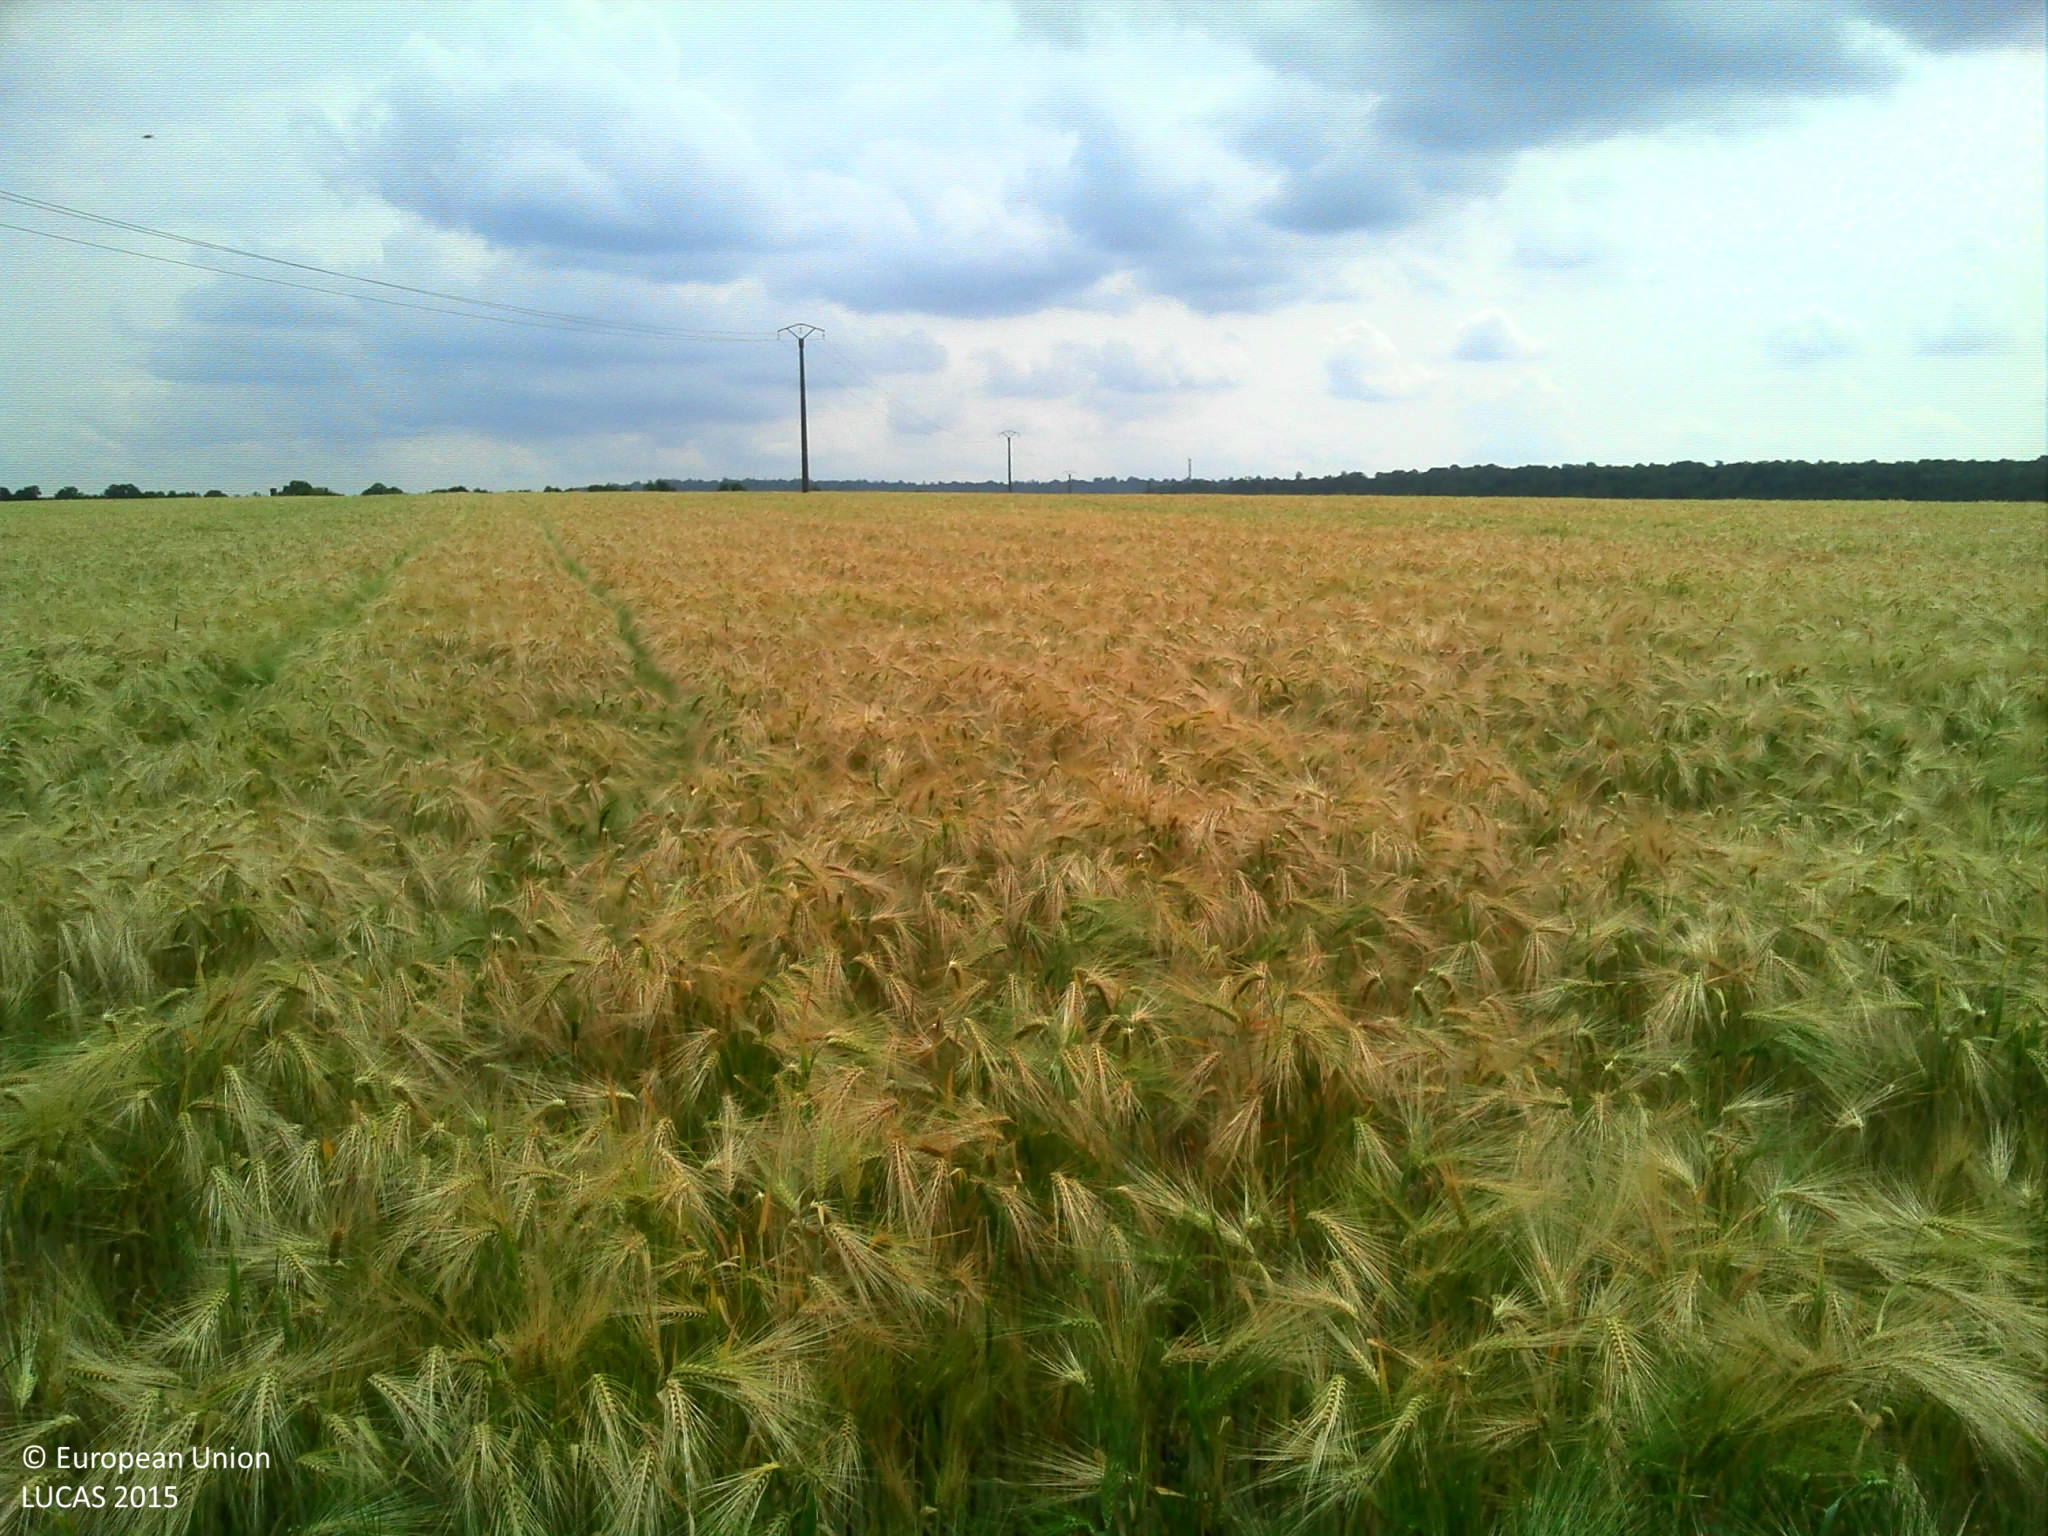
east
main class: Cropland
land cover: Barley
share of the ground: > 75 %
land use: Agriculture (excluding fallow land and kitchen gardens)
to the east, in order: Barley; Electric lines; Barley
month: June
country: FR
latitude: 48.7470
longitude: 6.0422
